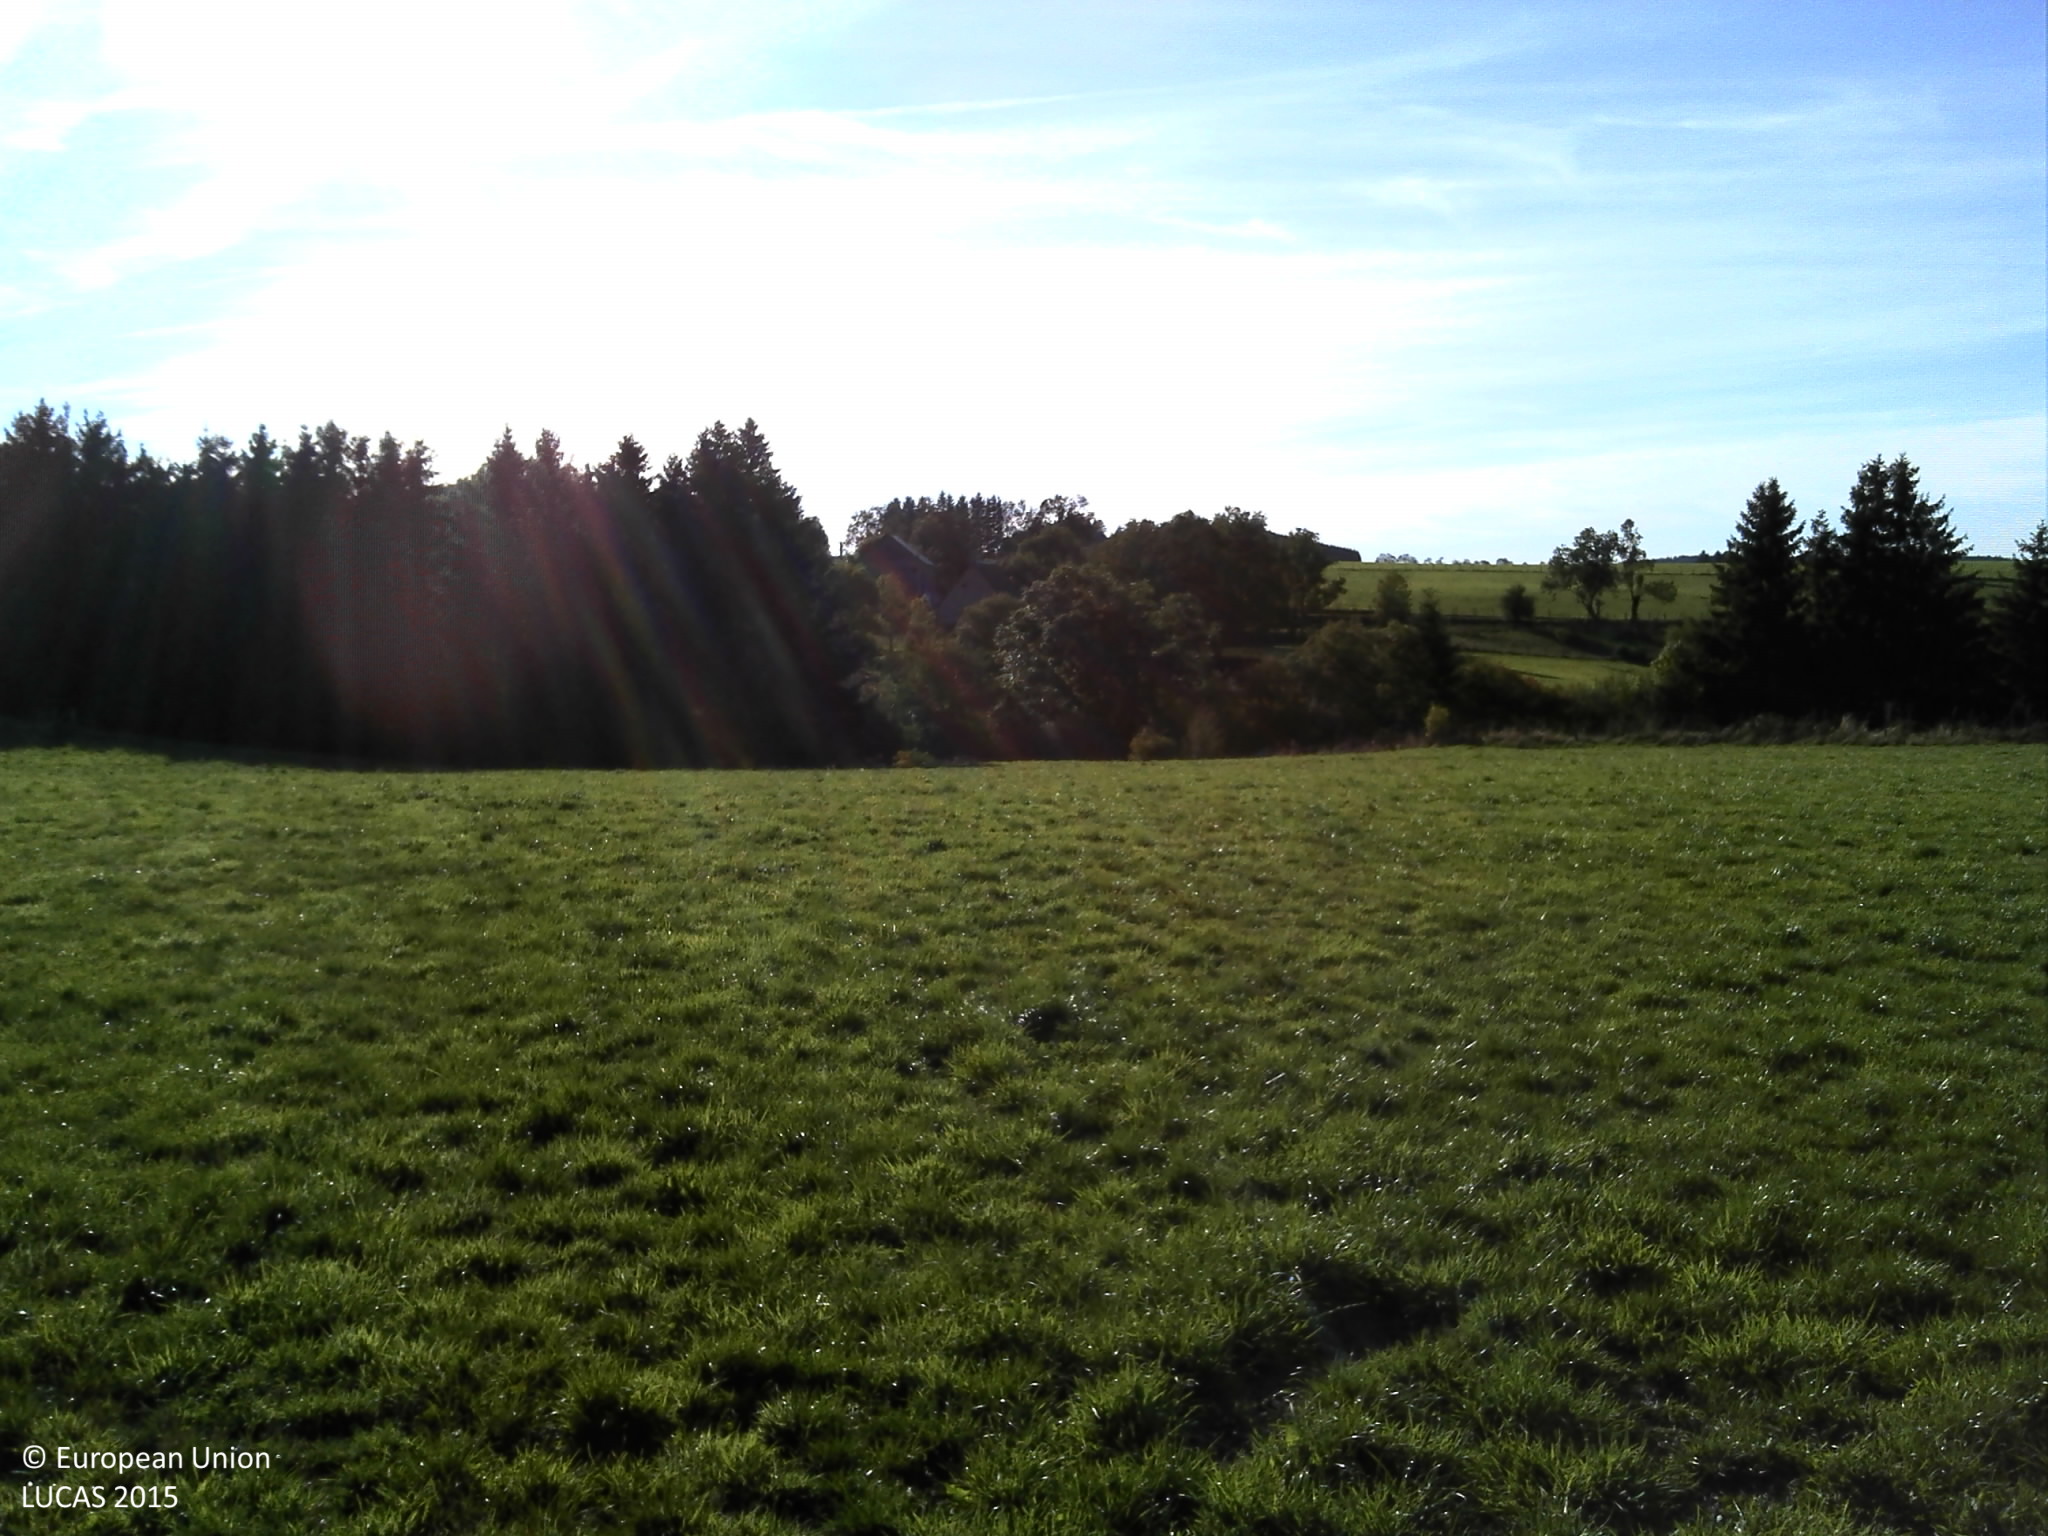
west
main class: Grassland
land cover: Grassland without tree/shrub cover
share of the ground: > 75 %
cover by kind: herbaceous plants 100 %
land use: Agriculture (excluding fallow land and kitchen gardens)
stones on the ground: < 10 %
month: September
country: FR
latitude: 45.6632
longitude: 2.9018
